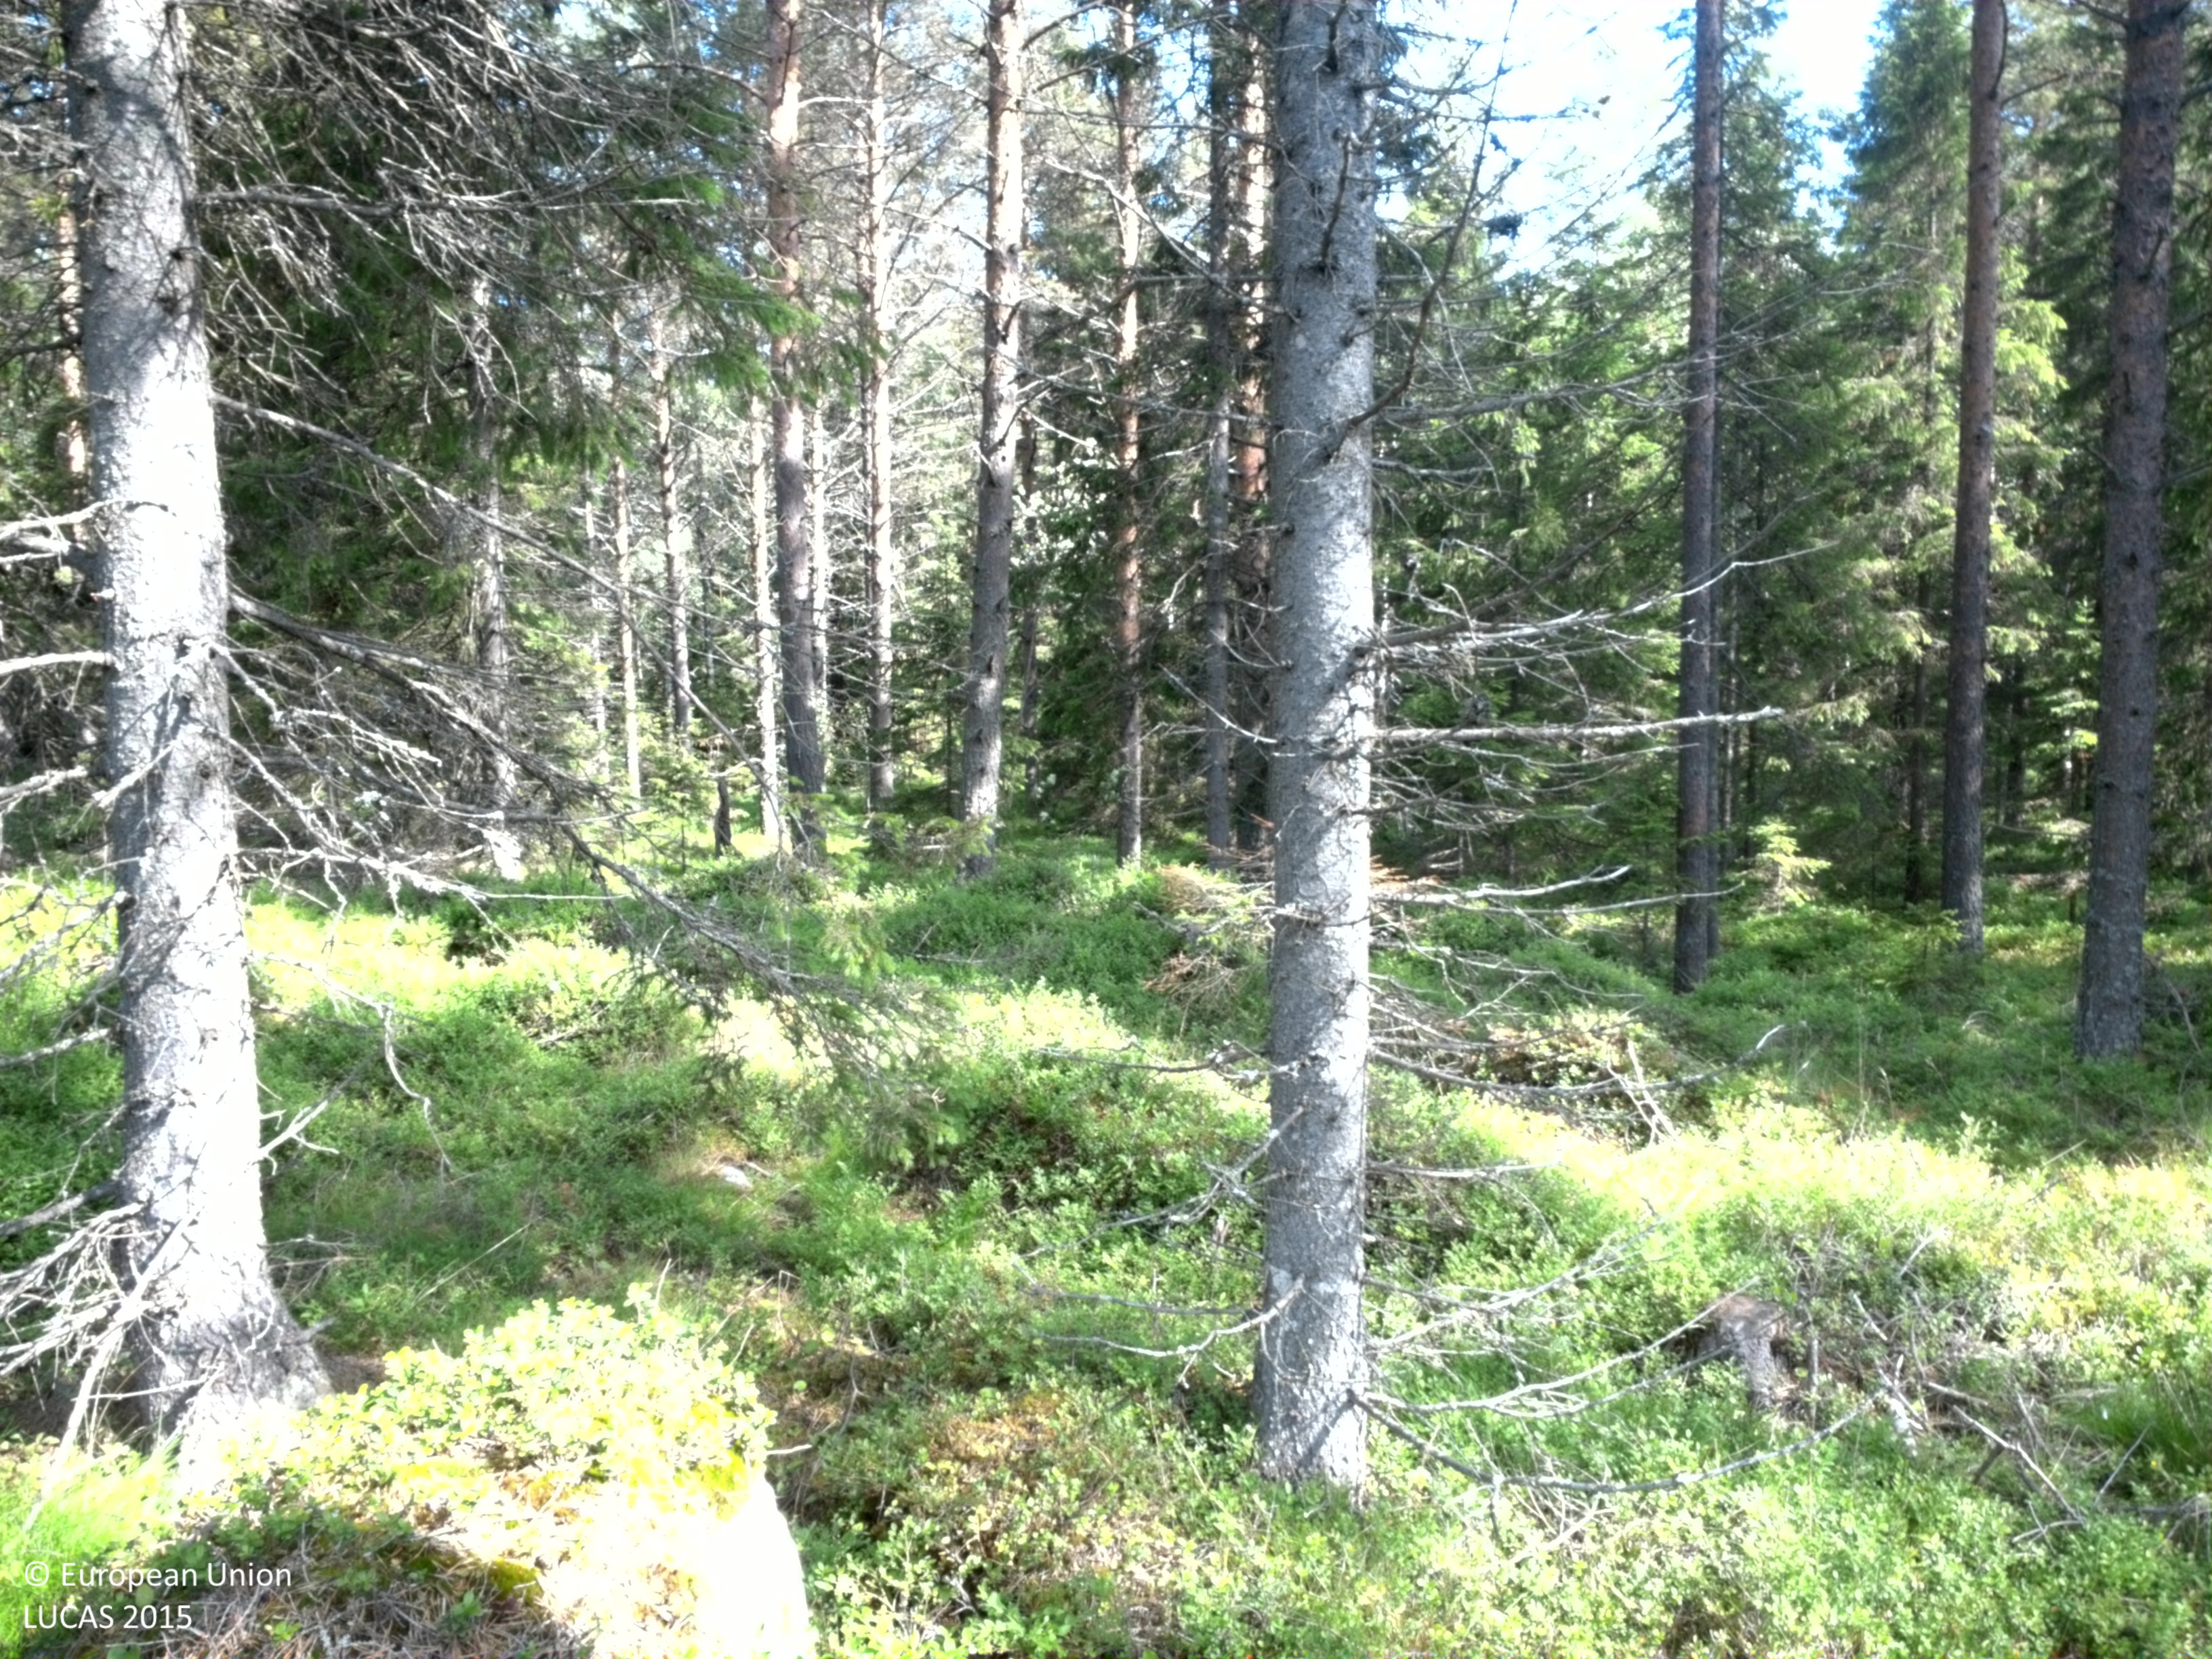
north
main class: Woodland
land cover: Pine dominated coniferous woodland
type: boreal forest
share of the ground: 50 - 75 %
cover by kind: coniferous forest trees 65 %, shrubs 35 %
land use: Forestry
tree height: > 5 m
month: July
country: SE
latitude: 64.4499
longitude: 21.5611
